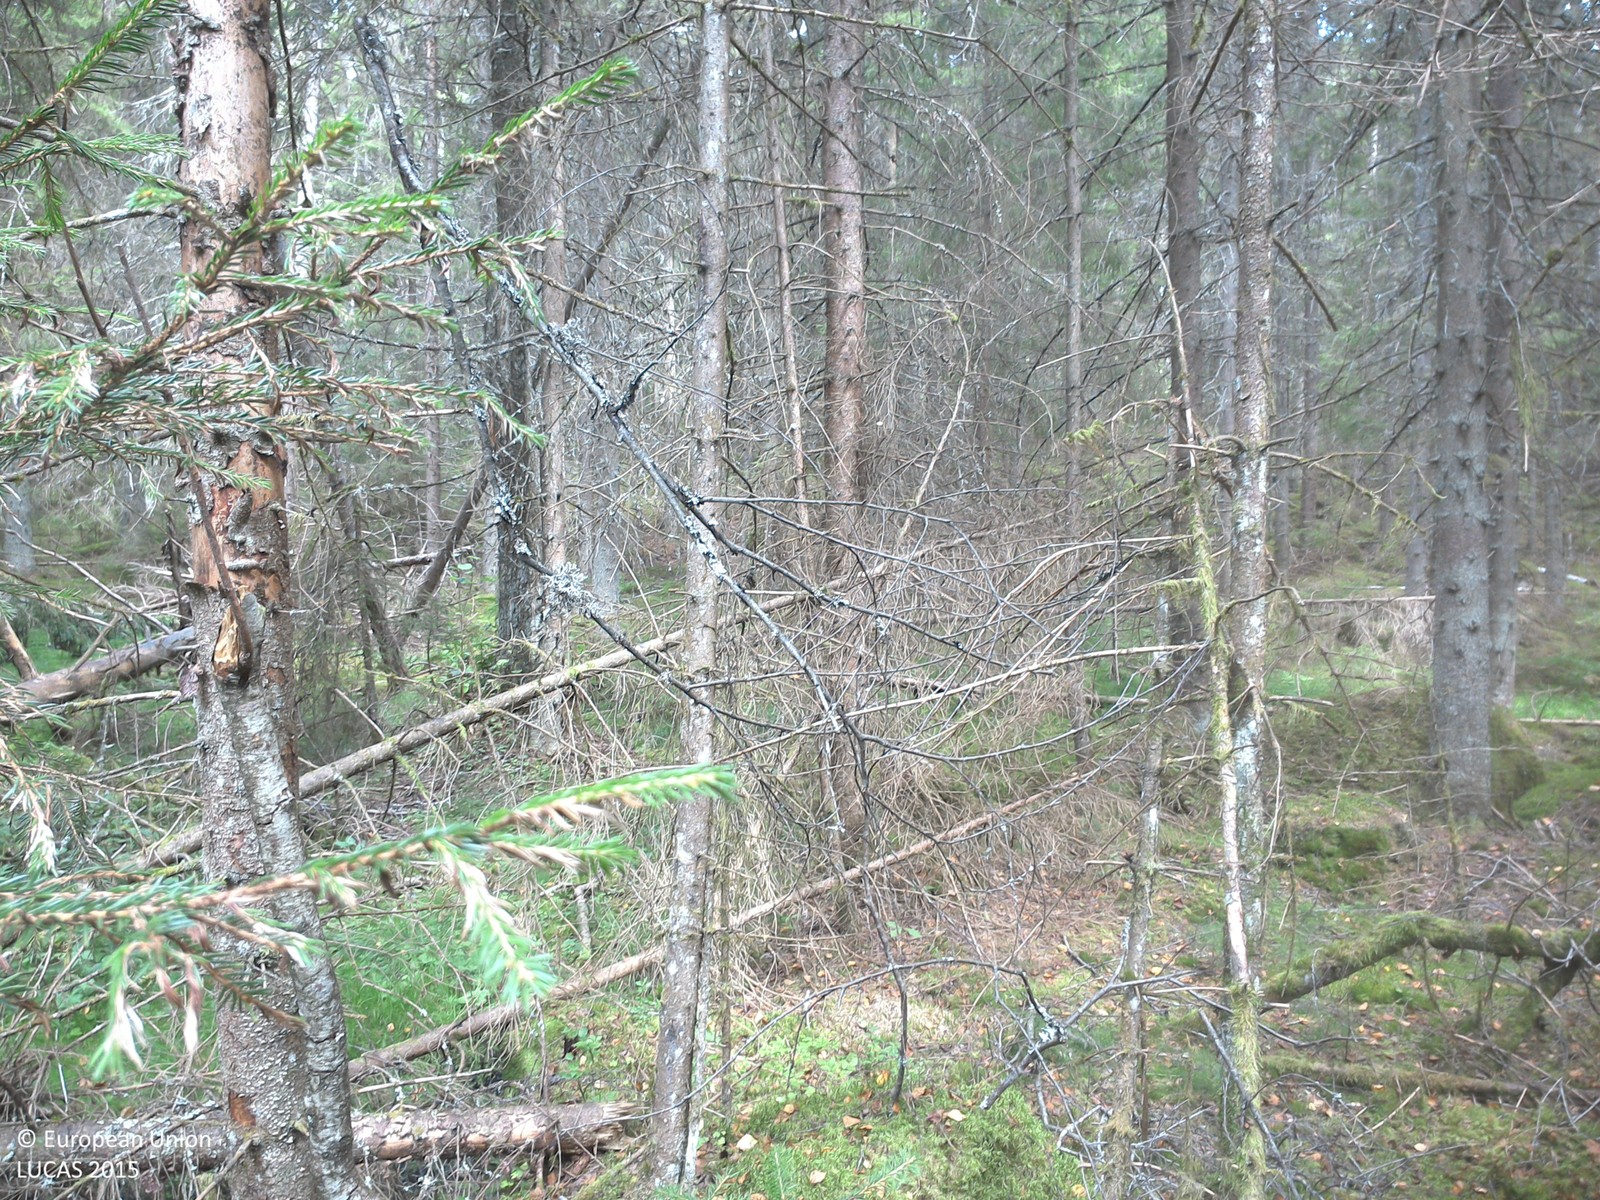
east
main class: Woodland
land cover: Spruce dominated coniferous woodland
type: boreal forest
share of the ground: 50 - 75 %
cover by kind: coniferous forest trees 70 %, herbaceous plants 20 %, lichens and mosses 10 %
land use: Forestry
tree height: > 5 m
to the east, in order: Spruce dominated coniferous woodland; Tracks; Pine dominated coniferous woodland; Spruce dominated coniferous woodland
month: August
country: SE
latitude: 57.9081
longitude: 15.5143
